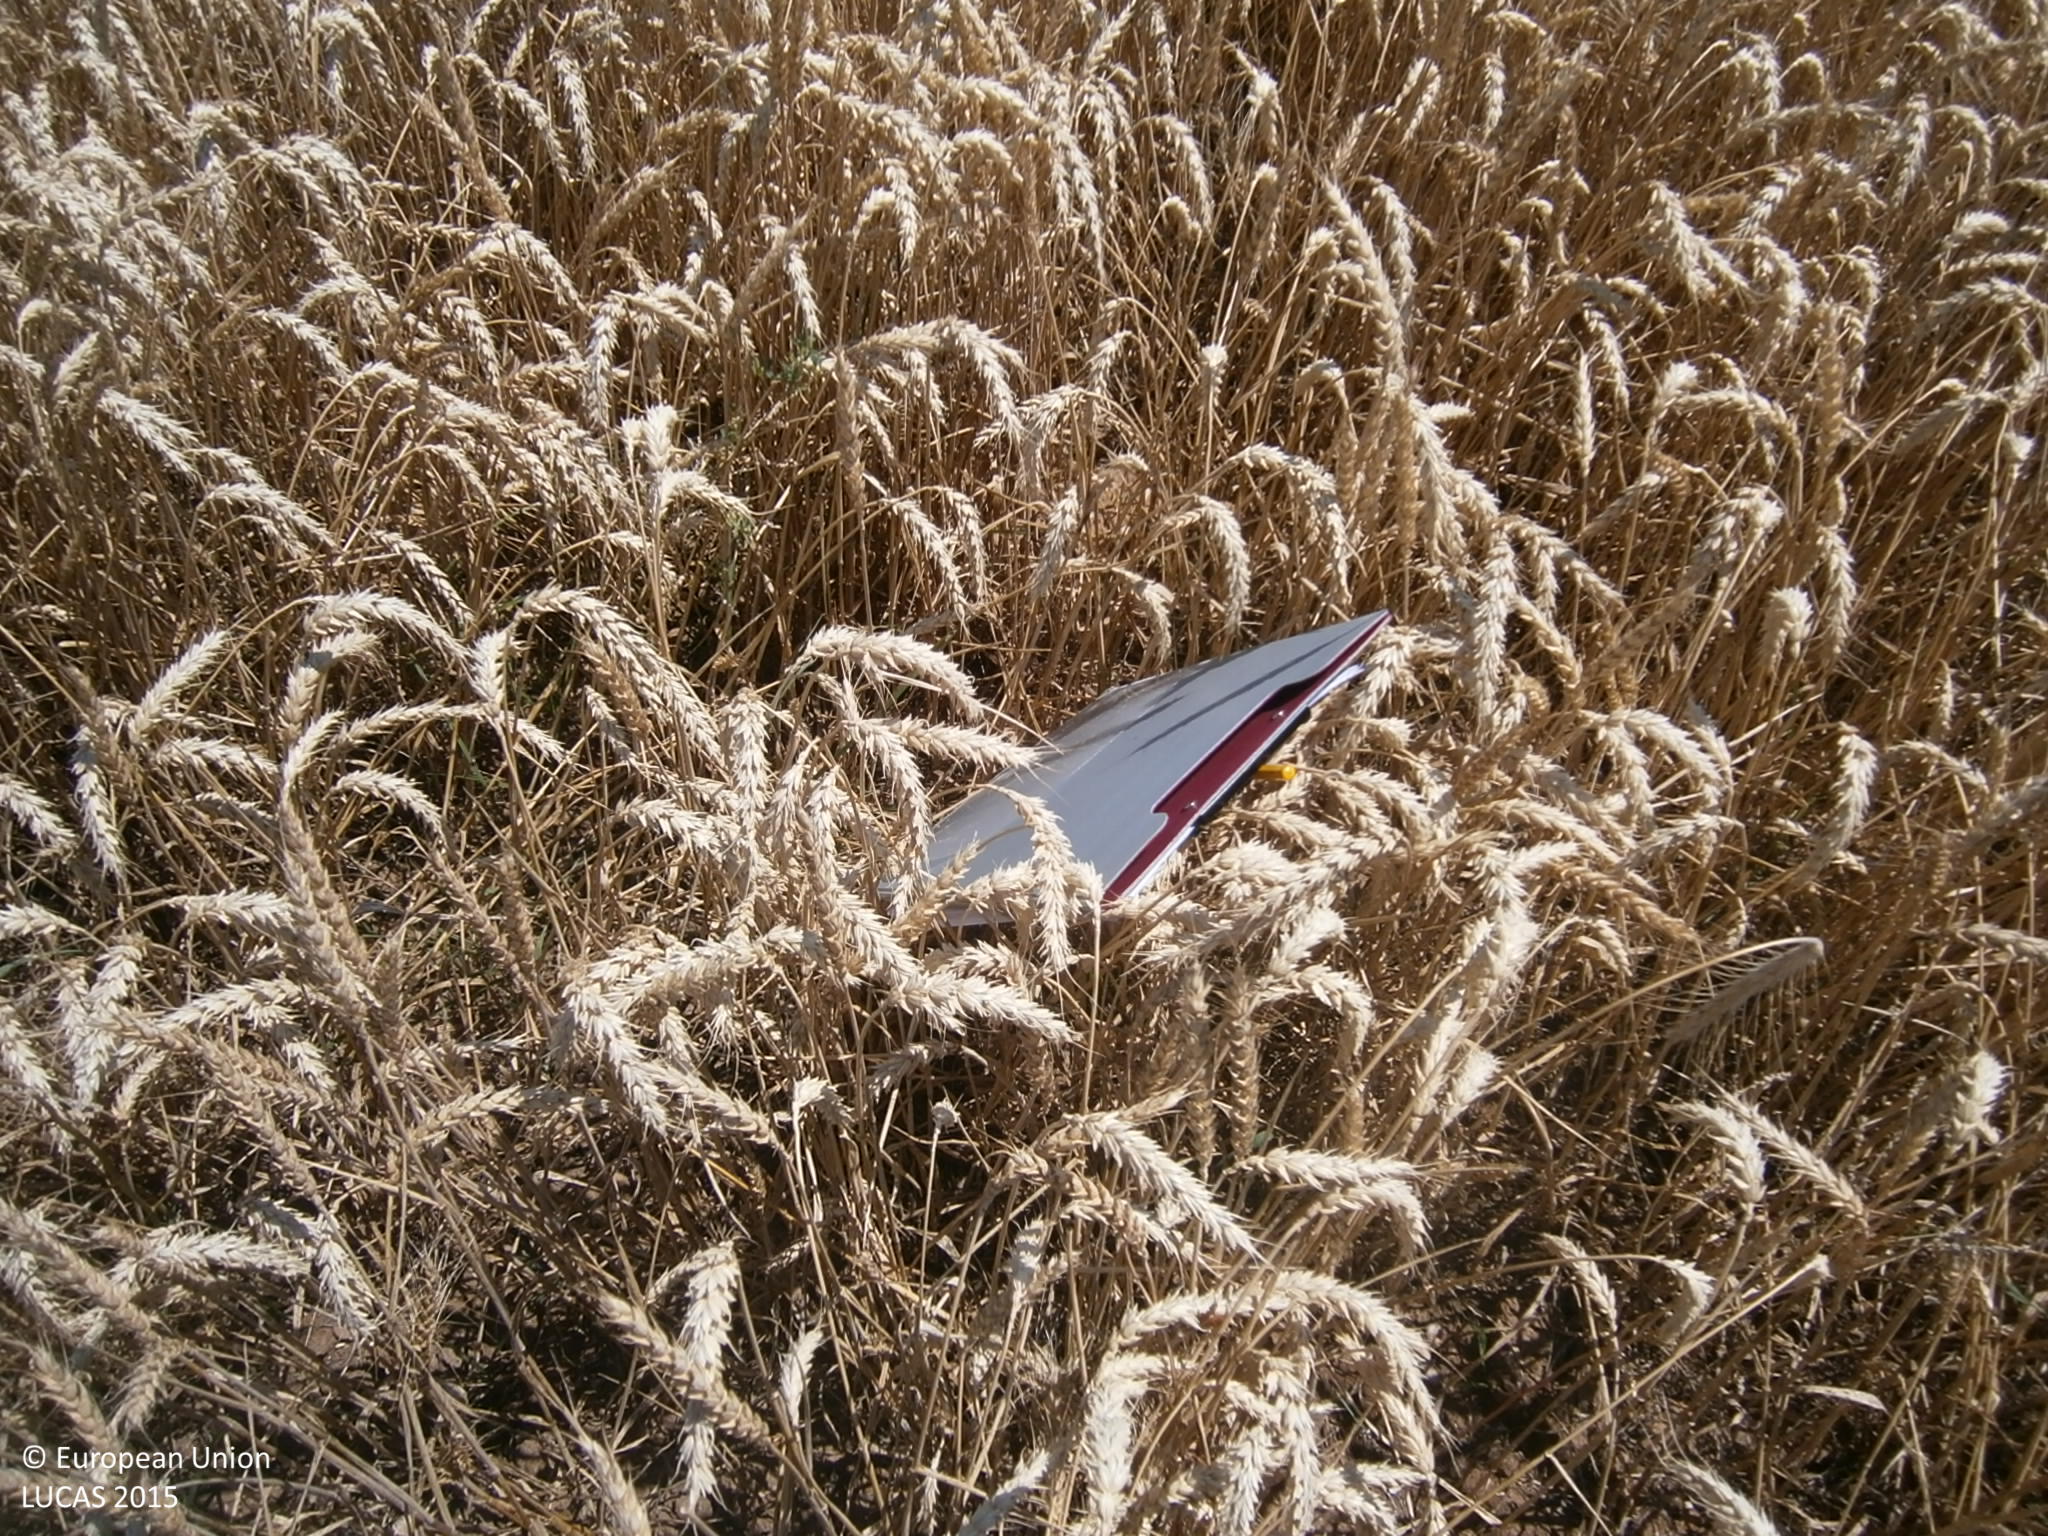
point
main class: Cropland
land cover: Barley
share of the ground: > 75 %
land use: Agriculture (excluding fallow land and kitchen gardens)
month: June
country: ES
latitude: 38.8449
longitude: -6.6889
